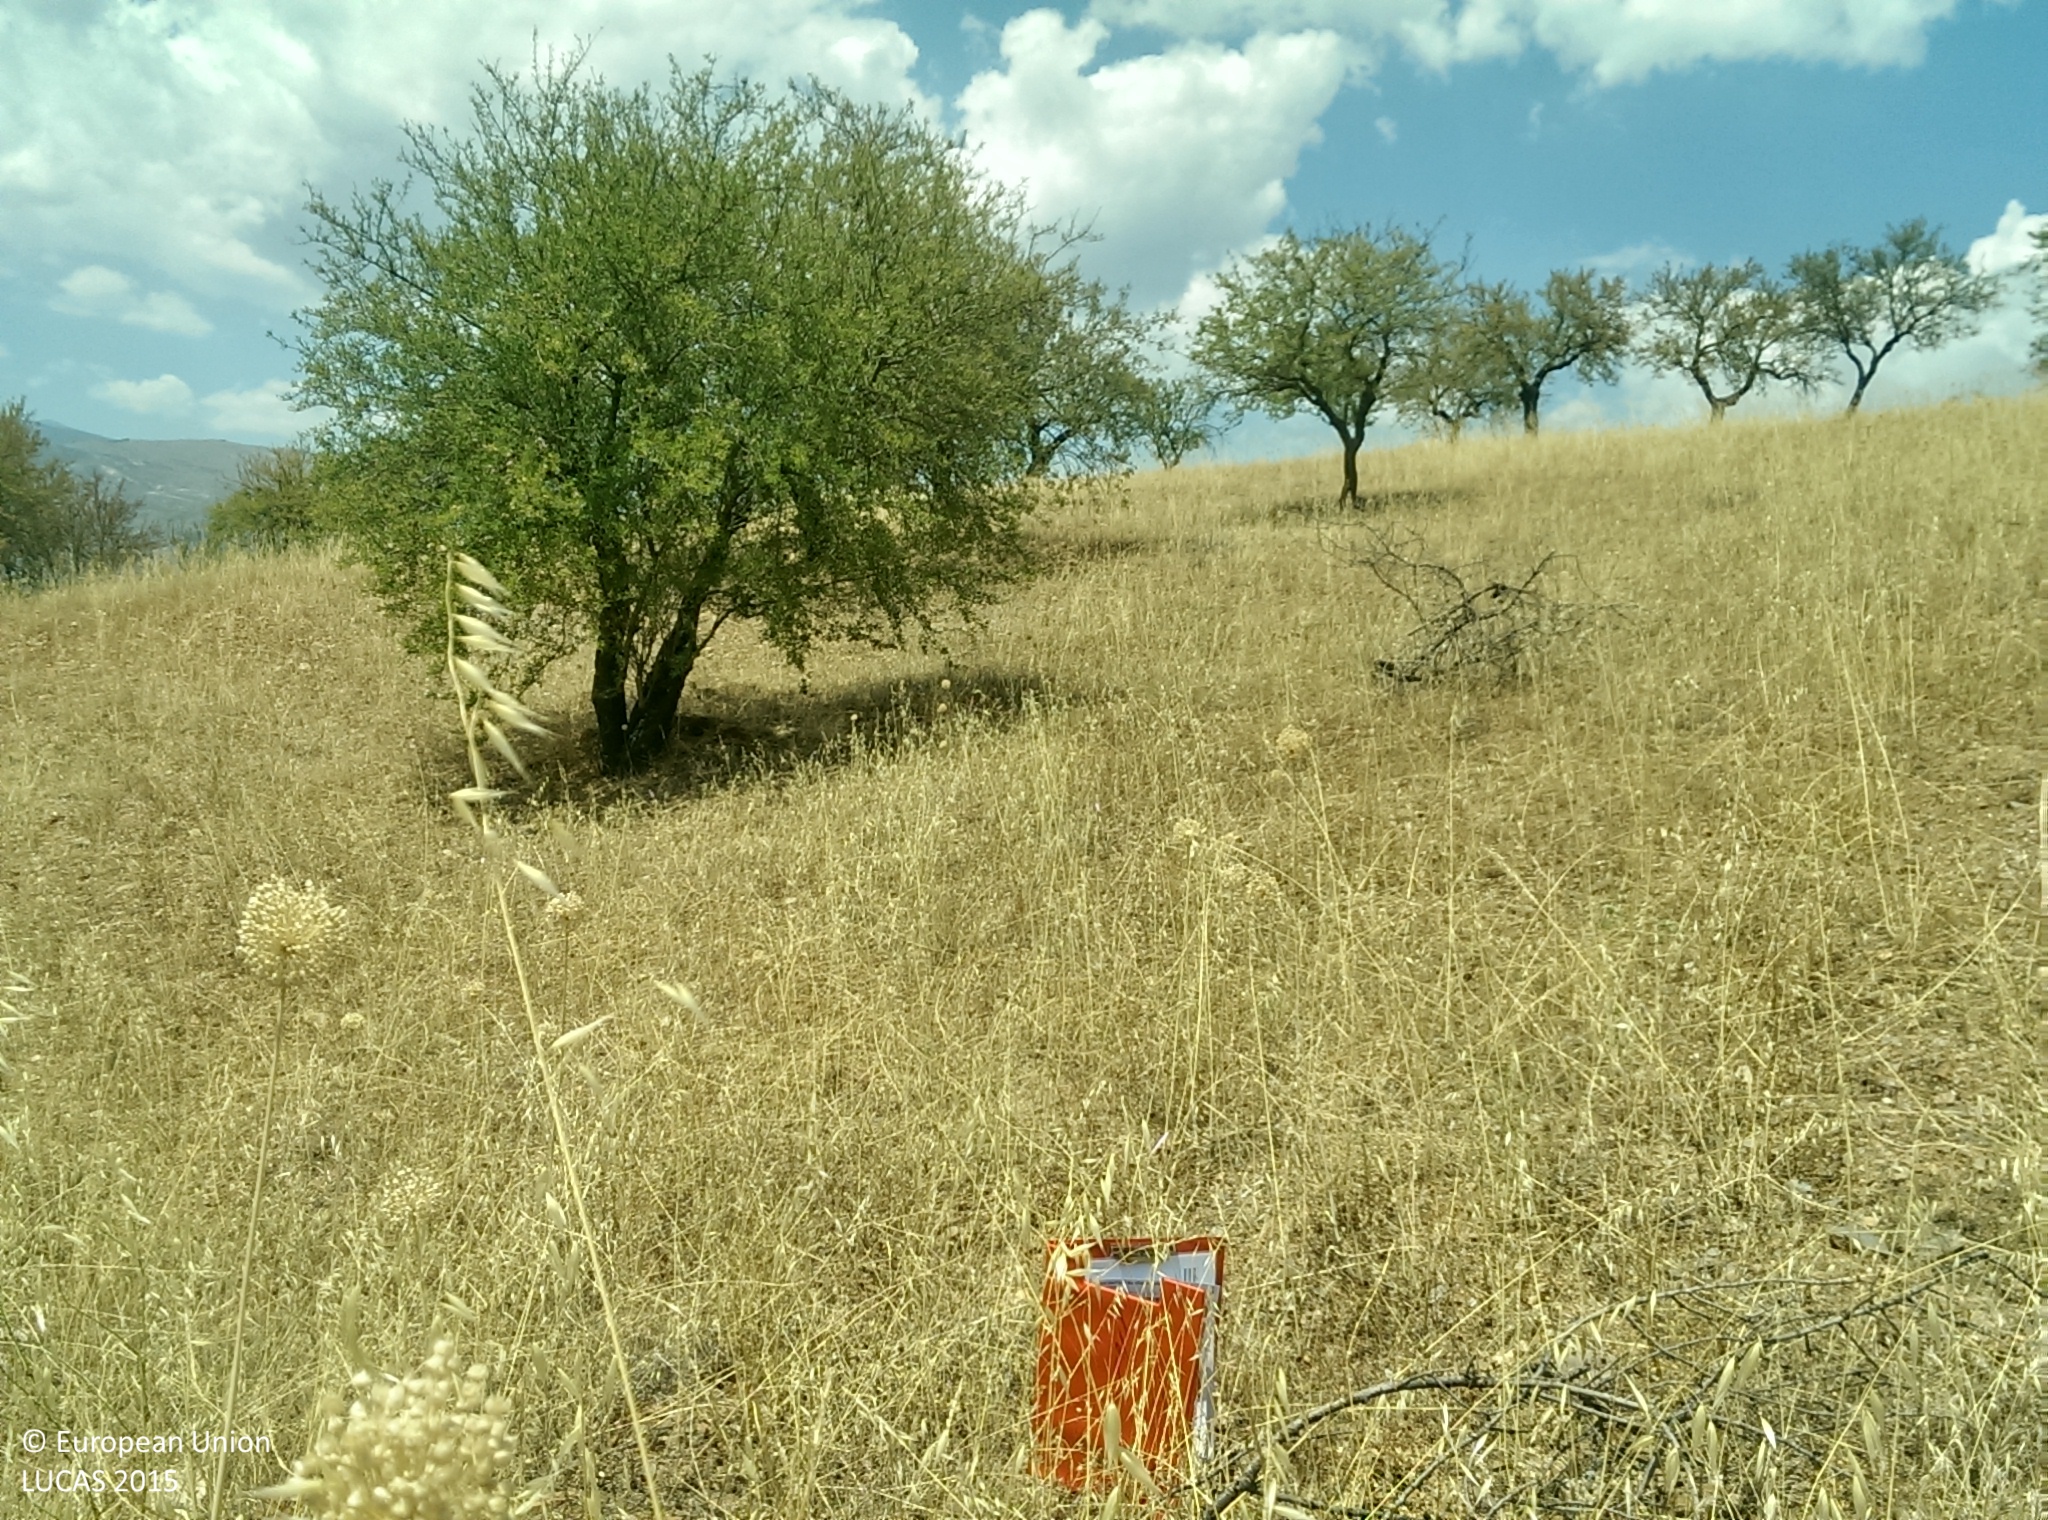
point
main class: Cropland
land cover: Nuts trees
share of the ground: 10 - 25 %
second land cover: Spontaneously vegetated surfaces
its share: 10 - 25 %
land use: Agriculture (excluding fallow land and kitchen gardens)
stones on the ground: 25 - 50 %
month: July
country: ES
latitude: 36.9460
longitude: -3.1081
